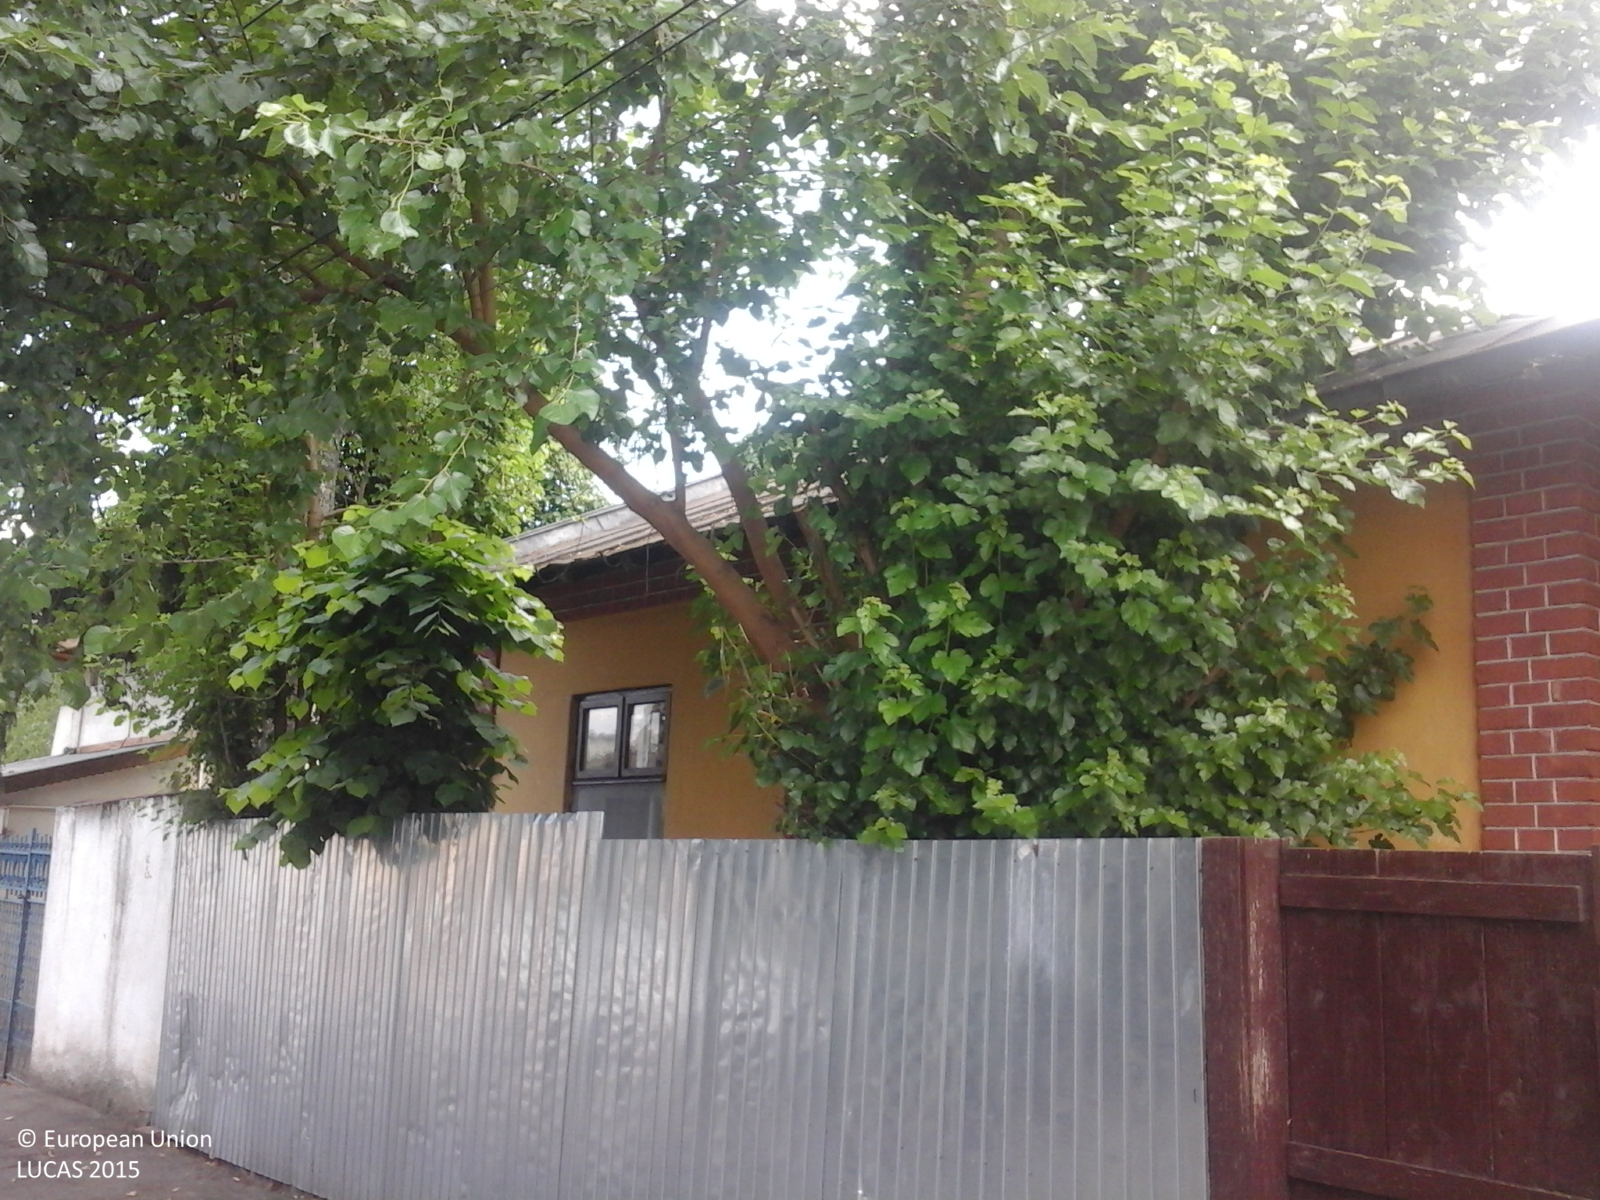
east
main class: Woodland
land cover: Broadleaved woodland
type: mesophytic deciduous forest
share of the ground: > 75 %
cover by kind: broadleaved forest trees 100 %
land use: Residential
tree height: > 5 m
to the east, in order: Broadleaved woodland; Artificial constructions in urban areas
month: June
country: RO
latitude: 44.4071
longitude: 26.0897
